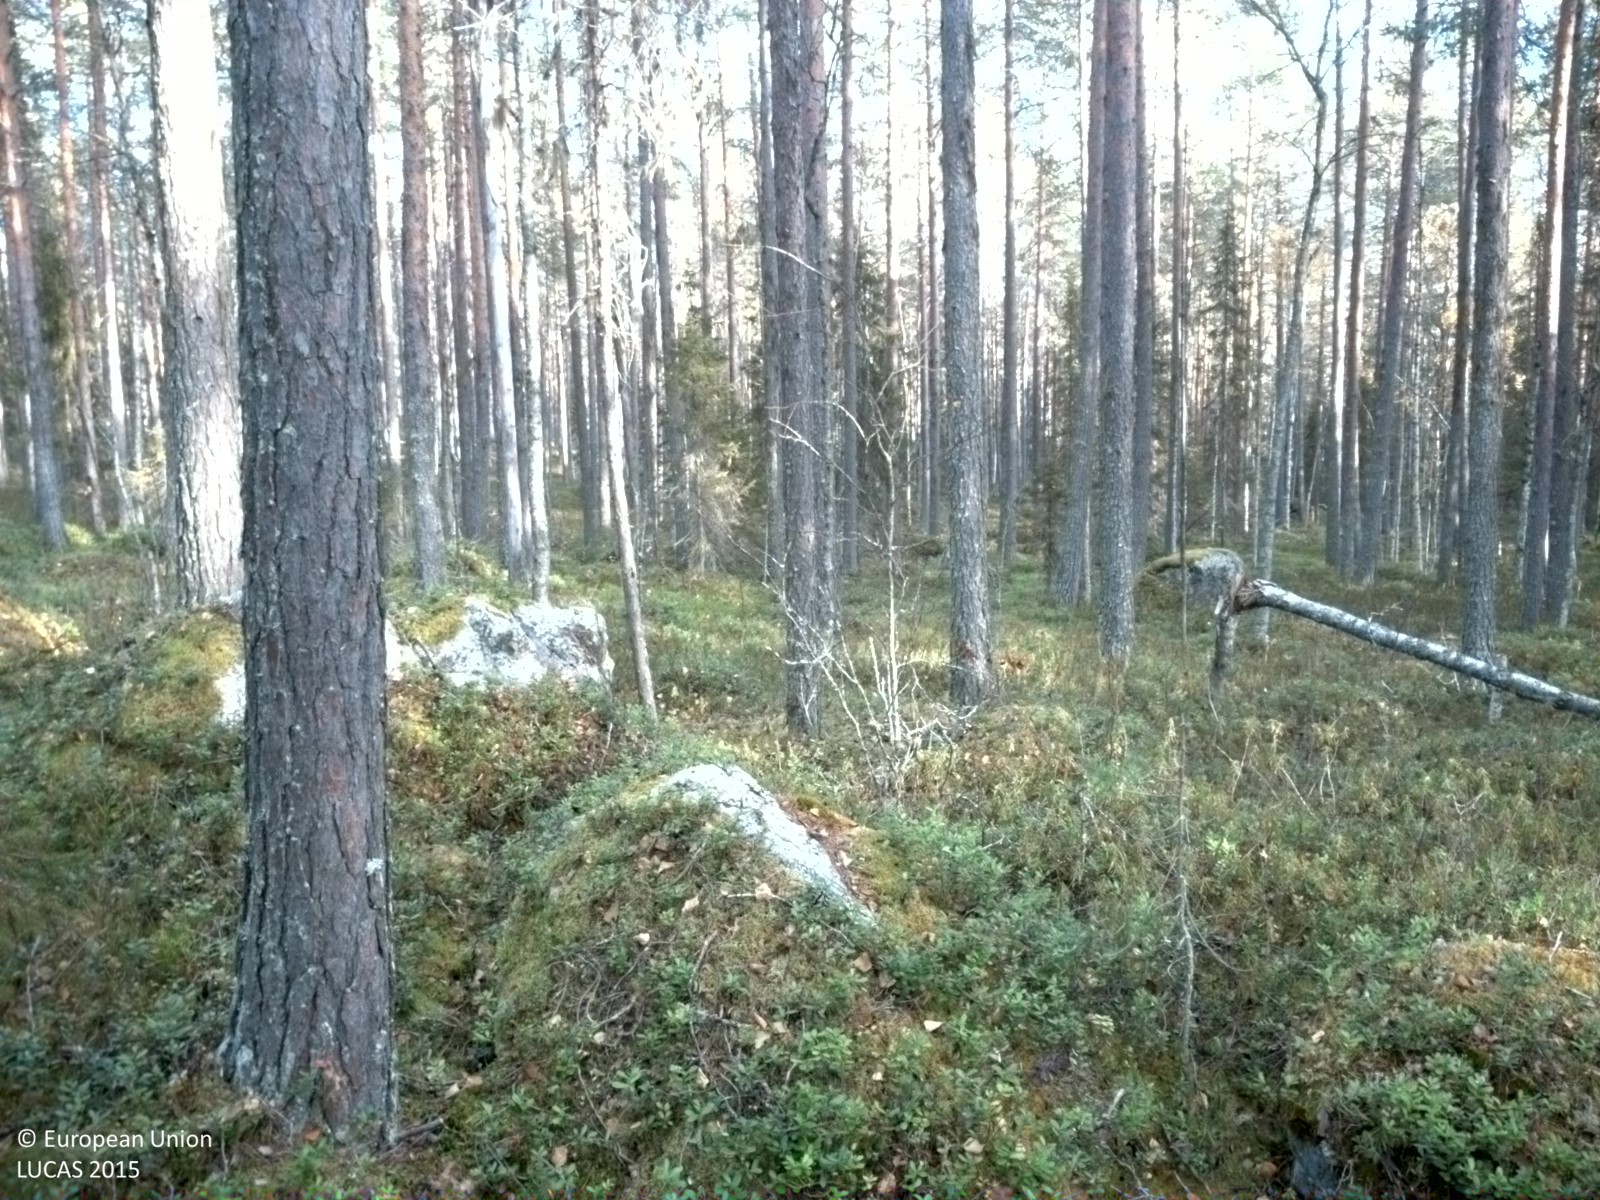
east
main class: Woodland
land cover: Pine dominated coniferous woodland
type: boreal forest
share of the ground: 25 - 50 %
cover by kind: shrubs 60 %, coniferous forest trees 35 %, consolidated bare surface 5 %
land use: Forestry
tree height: > 5 m
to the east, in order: Pine dominated coniferous woodland
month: October
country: SE
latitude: 65.9828
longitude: 22.1509
